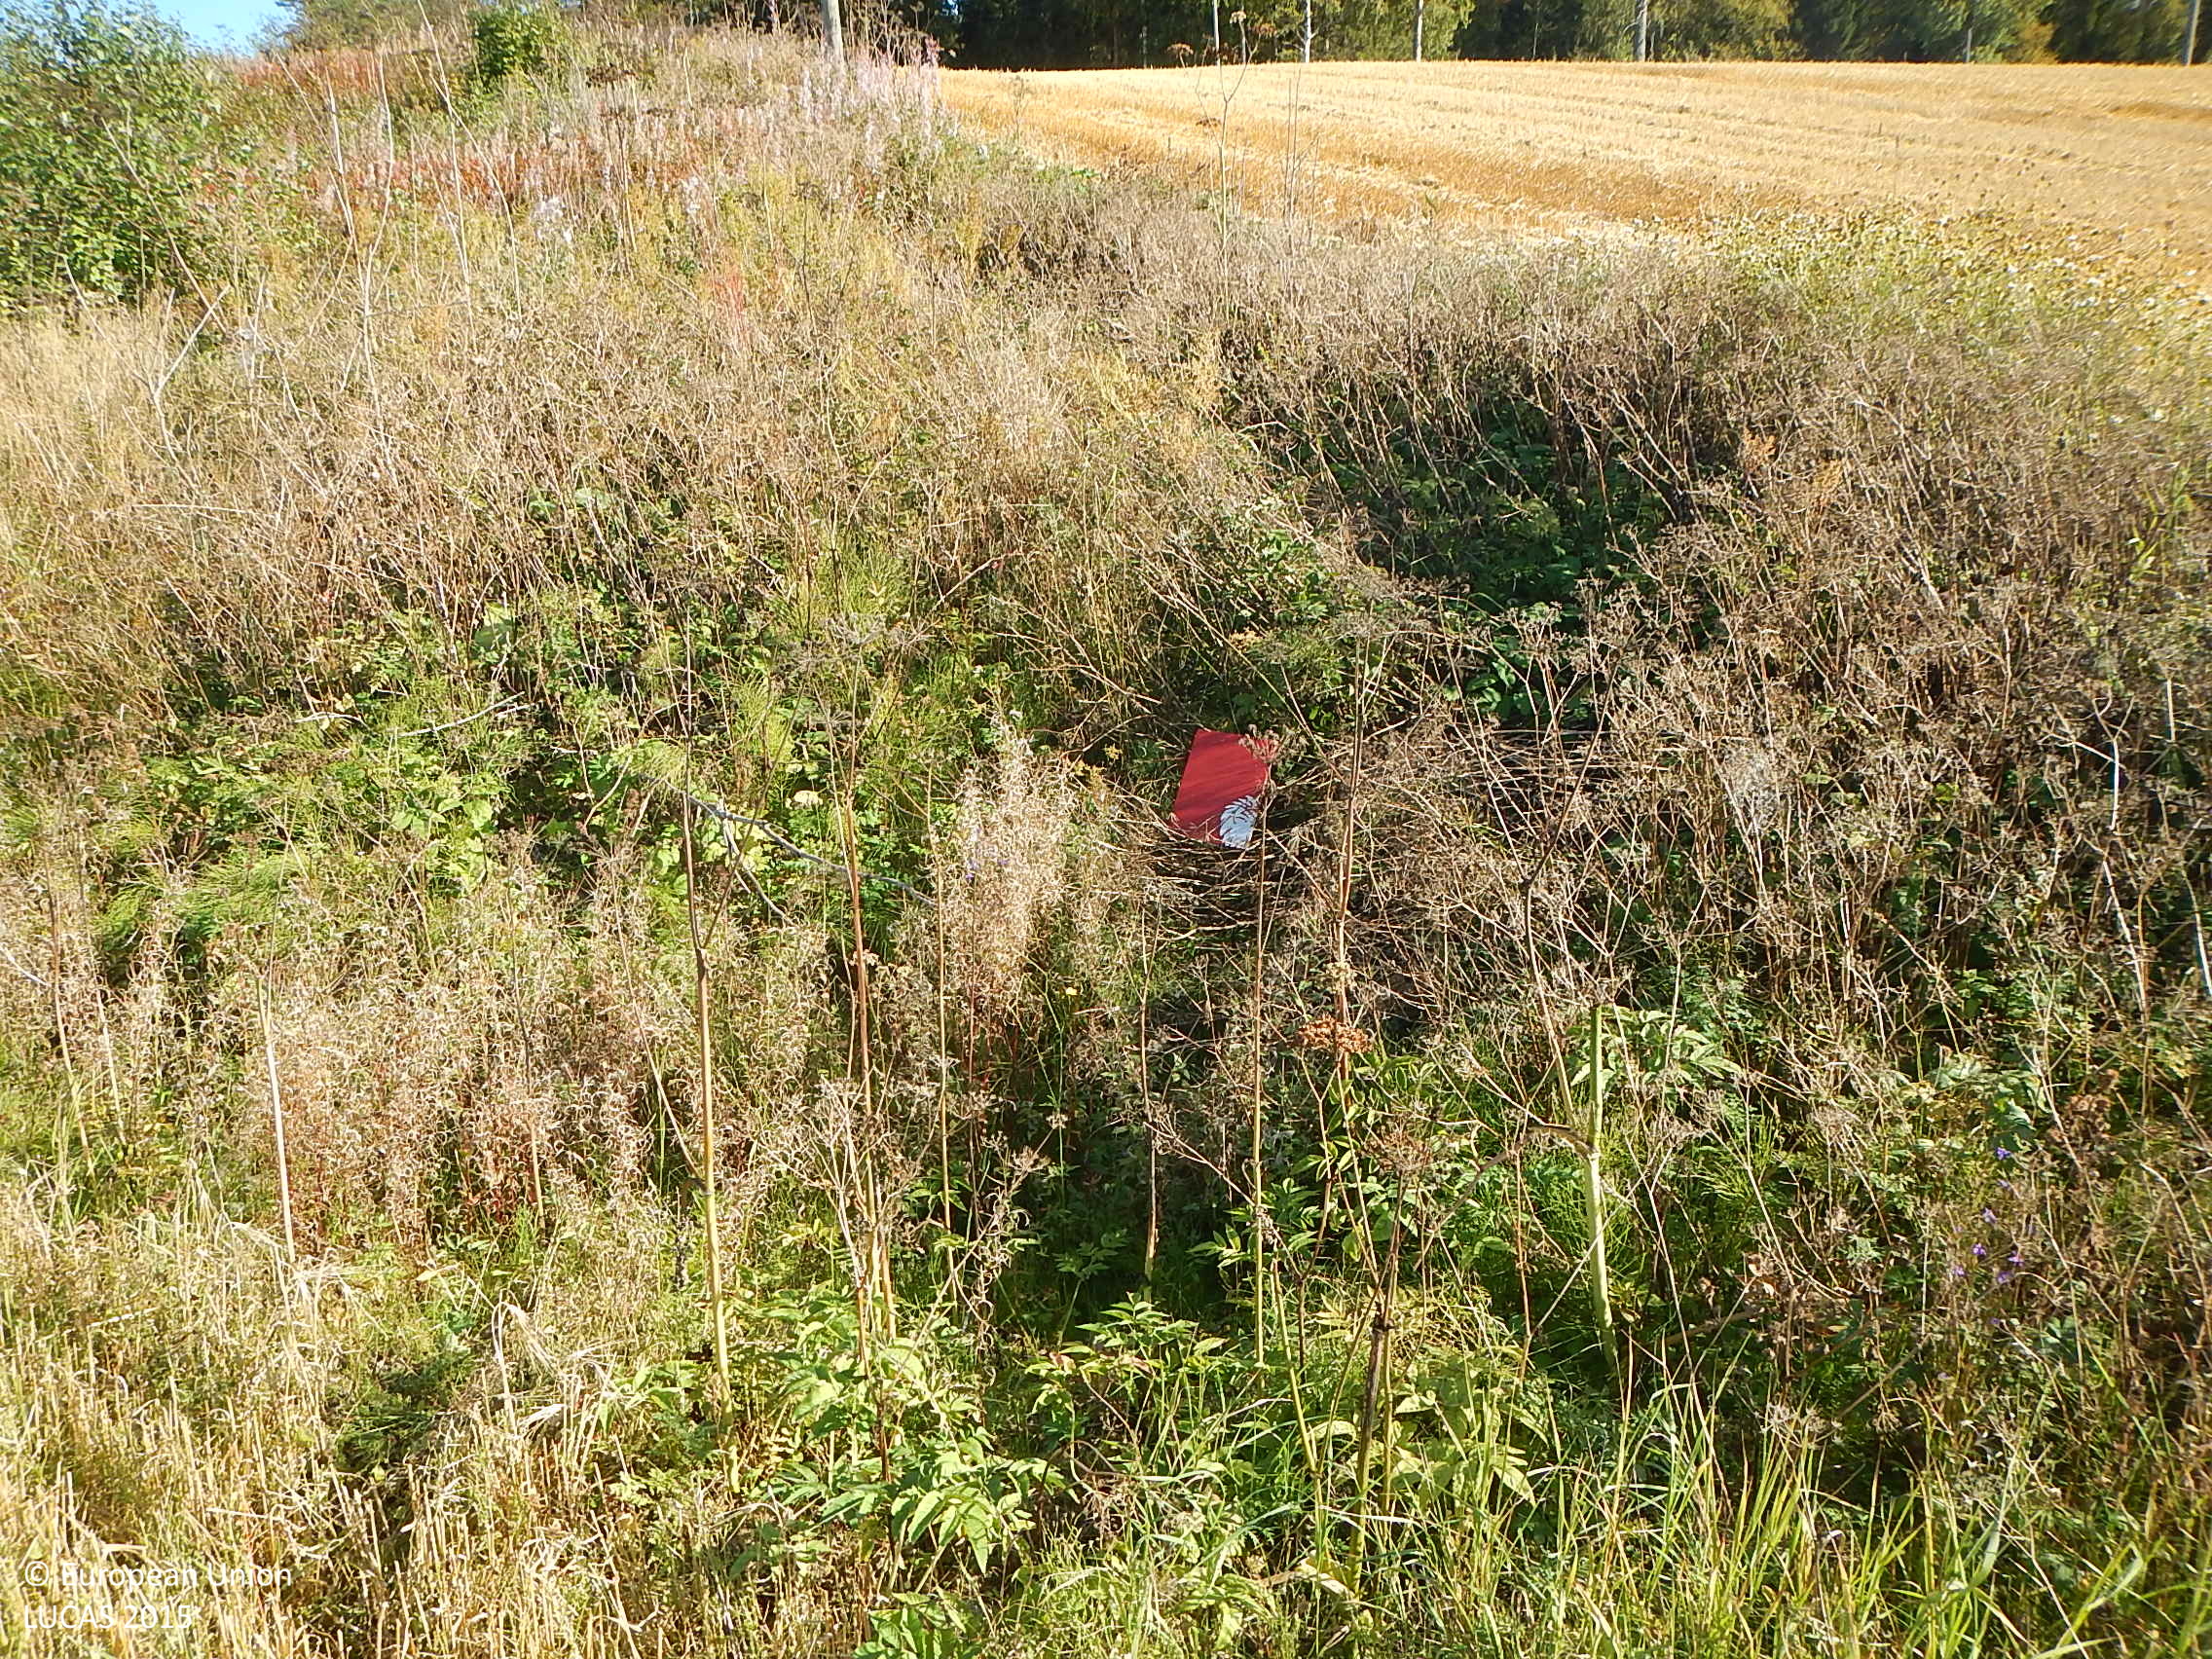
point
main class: Grassland
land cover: Spontaneously vegetated surfaces
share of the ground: > 75 %
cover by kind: herbaceous plants 100 %
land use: Semi-natural and natural areas not in use
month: September
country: FI
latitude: 61.6450
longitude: 22.7690
